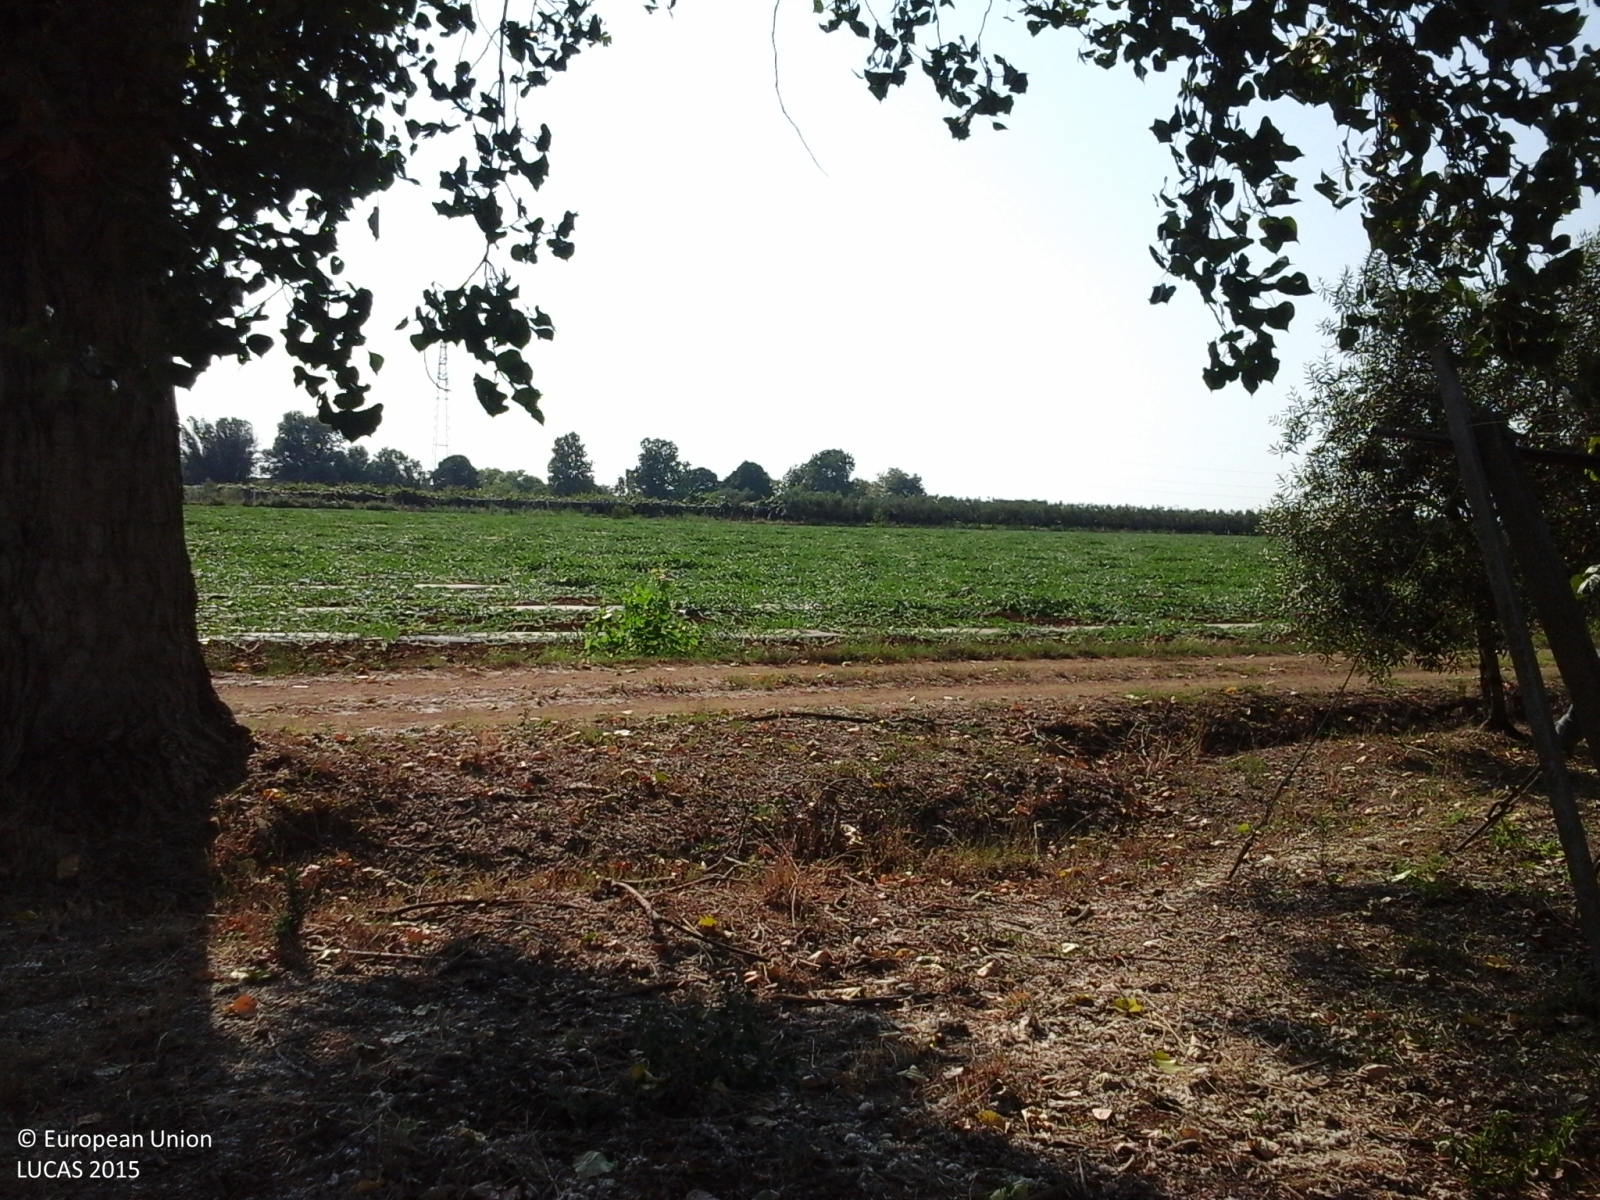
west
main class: Cropland
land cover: Other fruit trees and berries
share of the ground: > 75 %
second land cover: Grassland without tree/shrub cover
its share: > 75 %
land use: Agriculture (excluding fallow land and kitchen gardens)
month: July
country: IT
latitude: 41.5659
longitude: 12.8309
